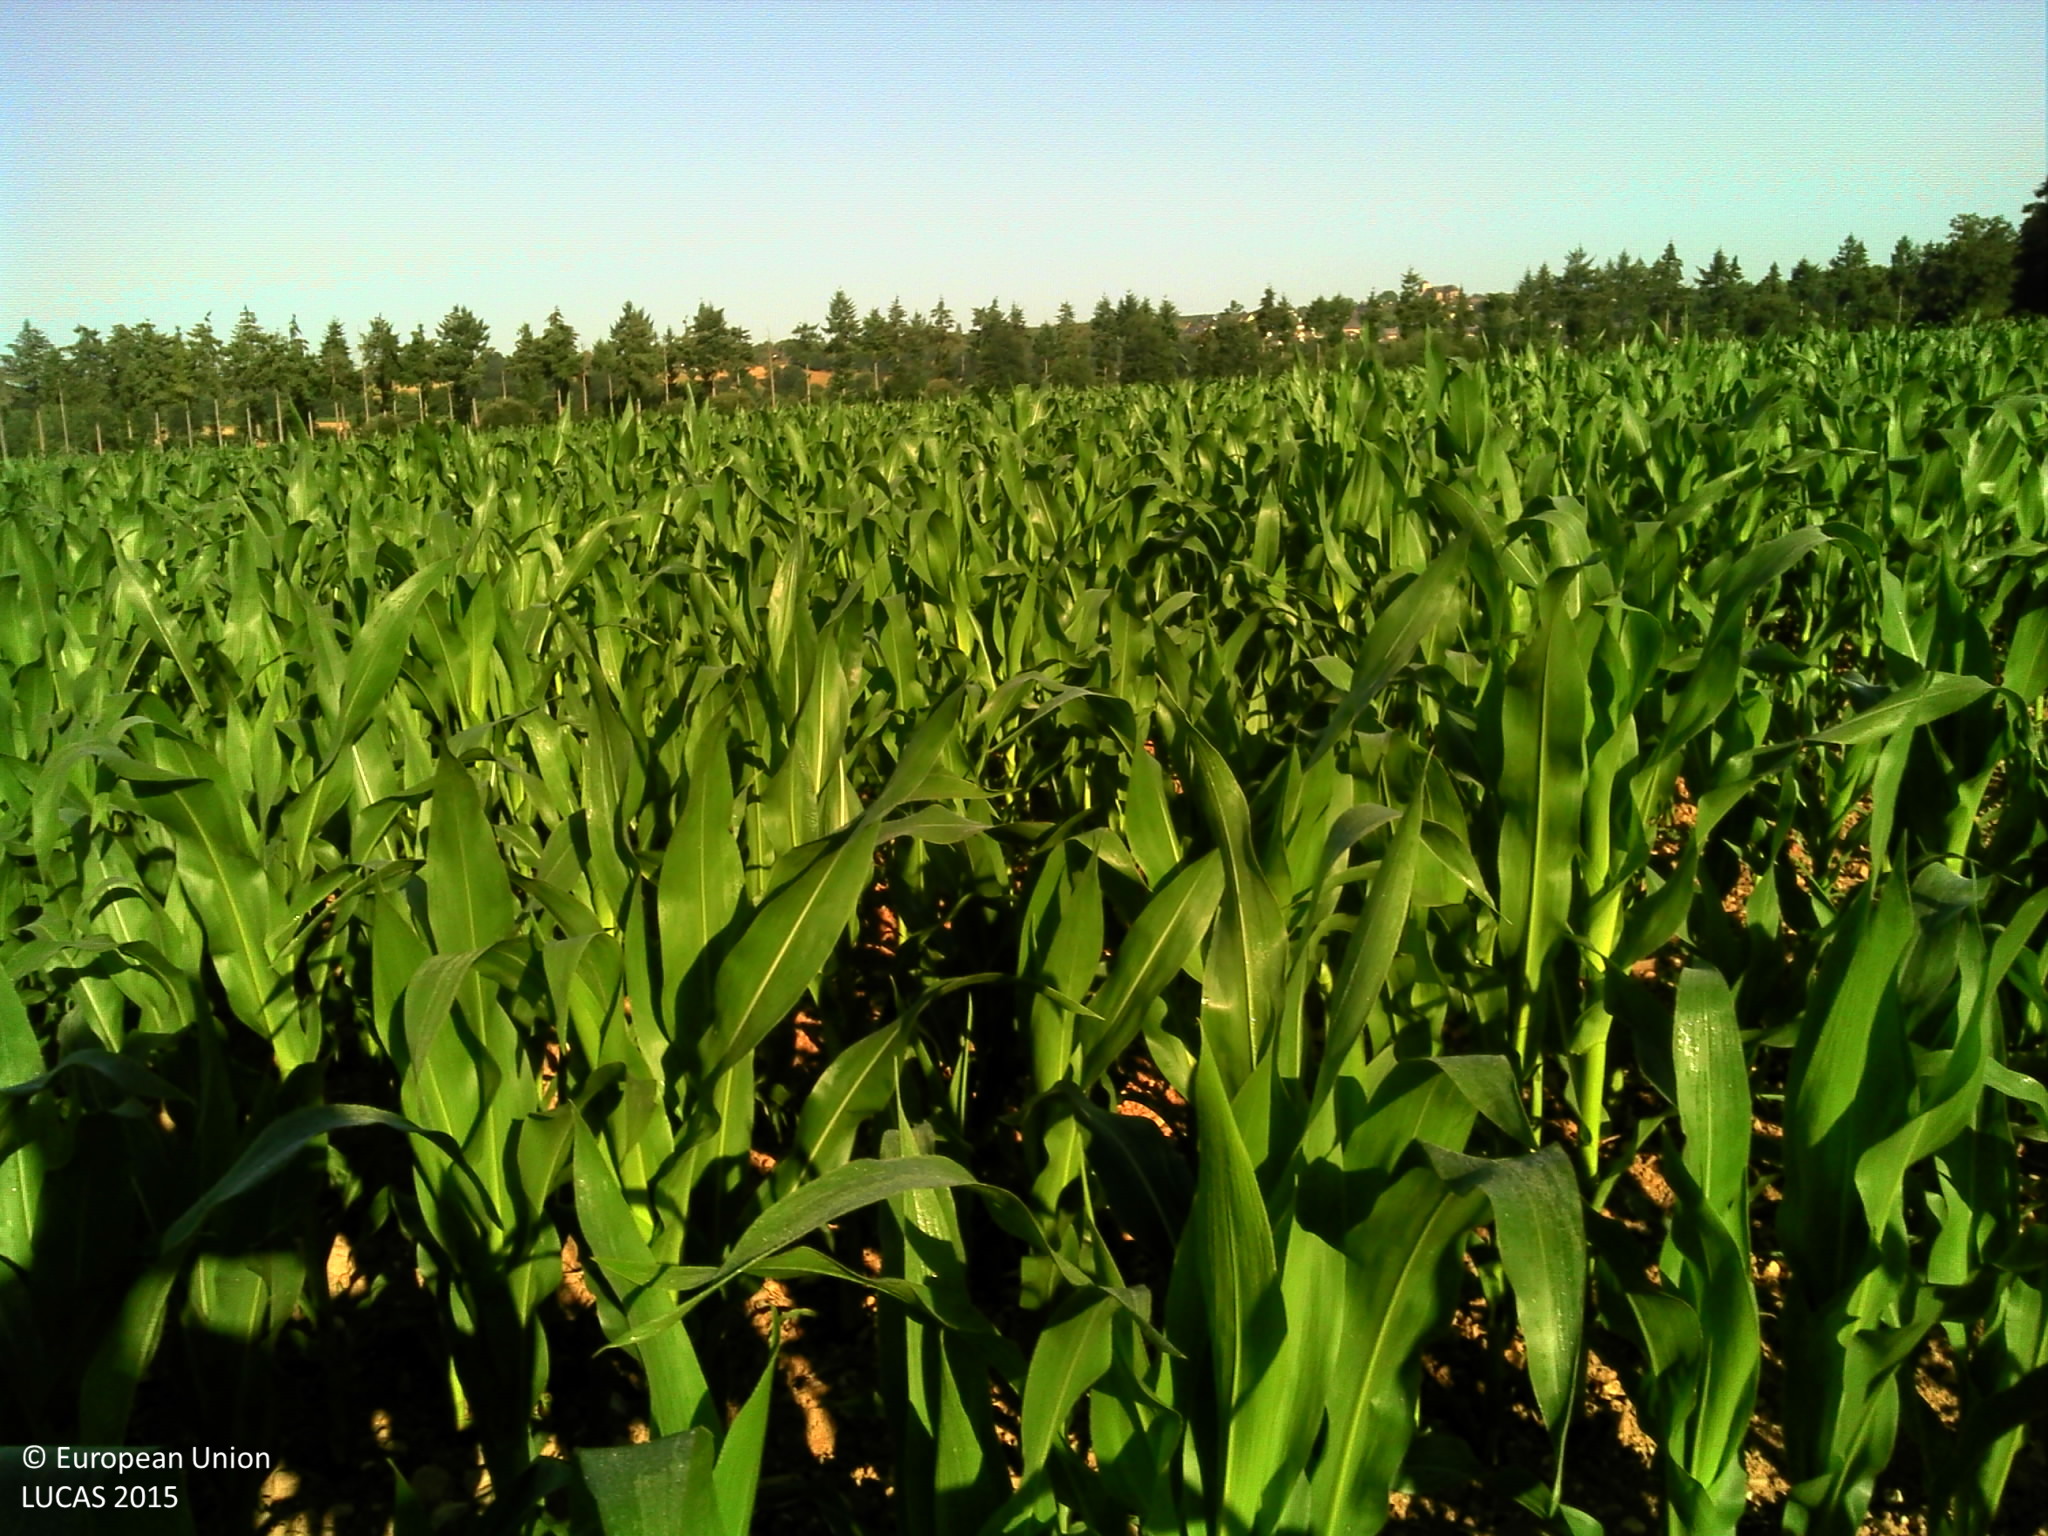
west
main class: Cropland
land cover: Maize
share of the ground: > 75 %
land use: Agriculture (excluding fallow land and kitchen gardens)
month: July
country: FR
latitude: 48.1028
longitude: -1.9092
